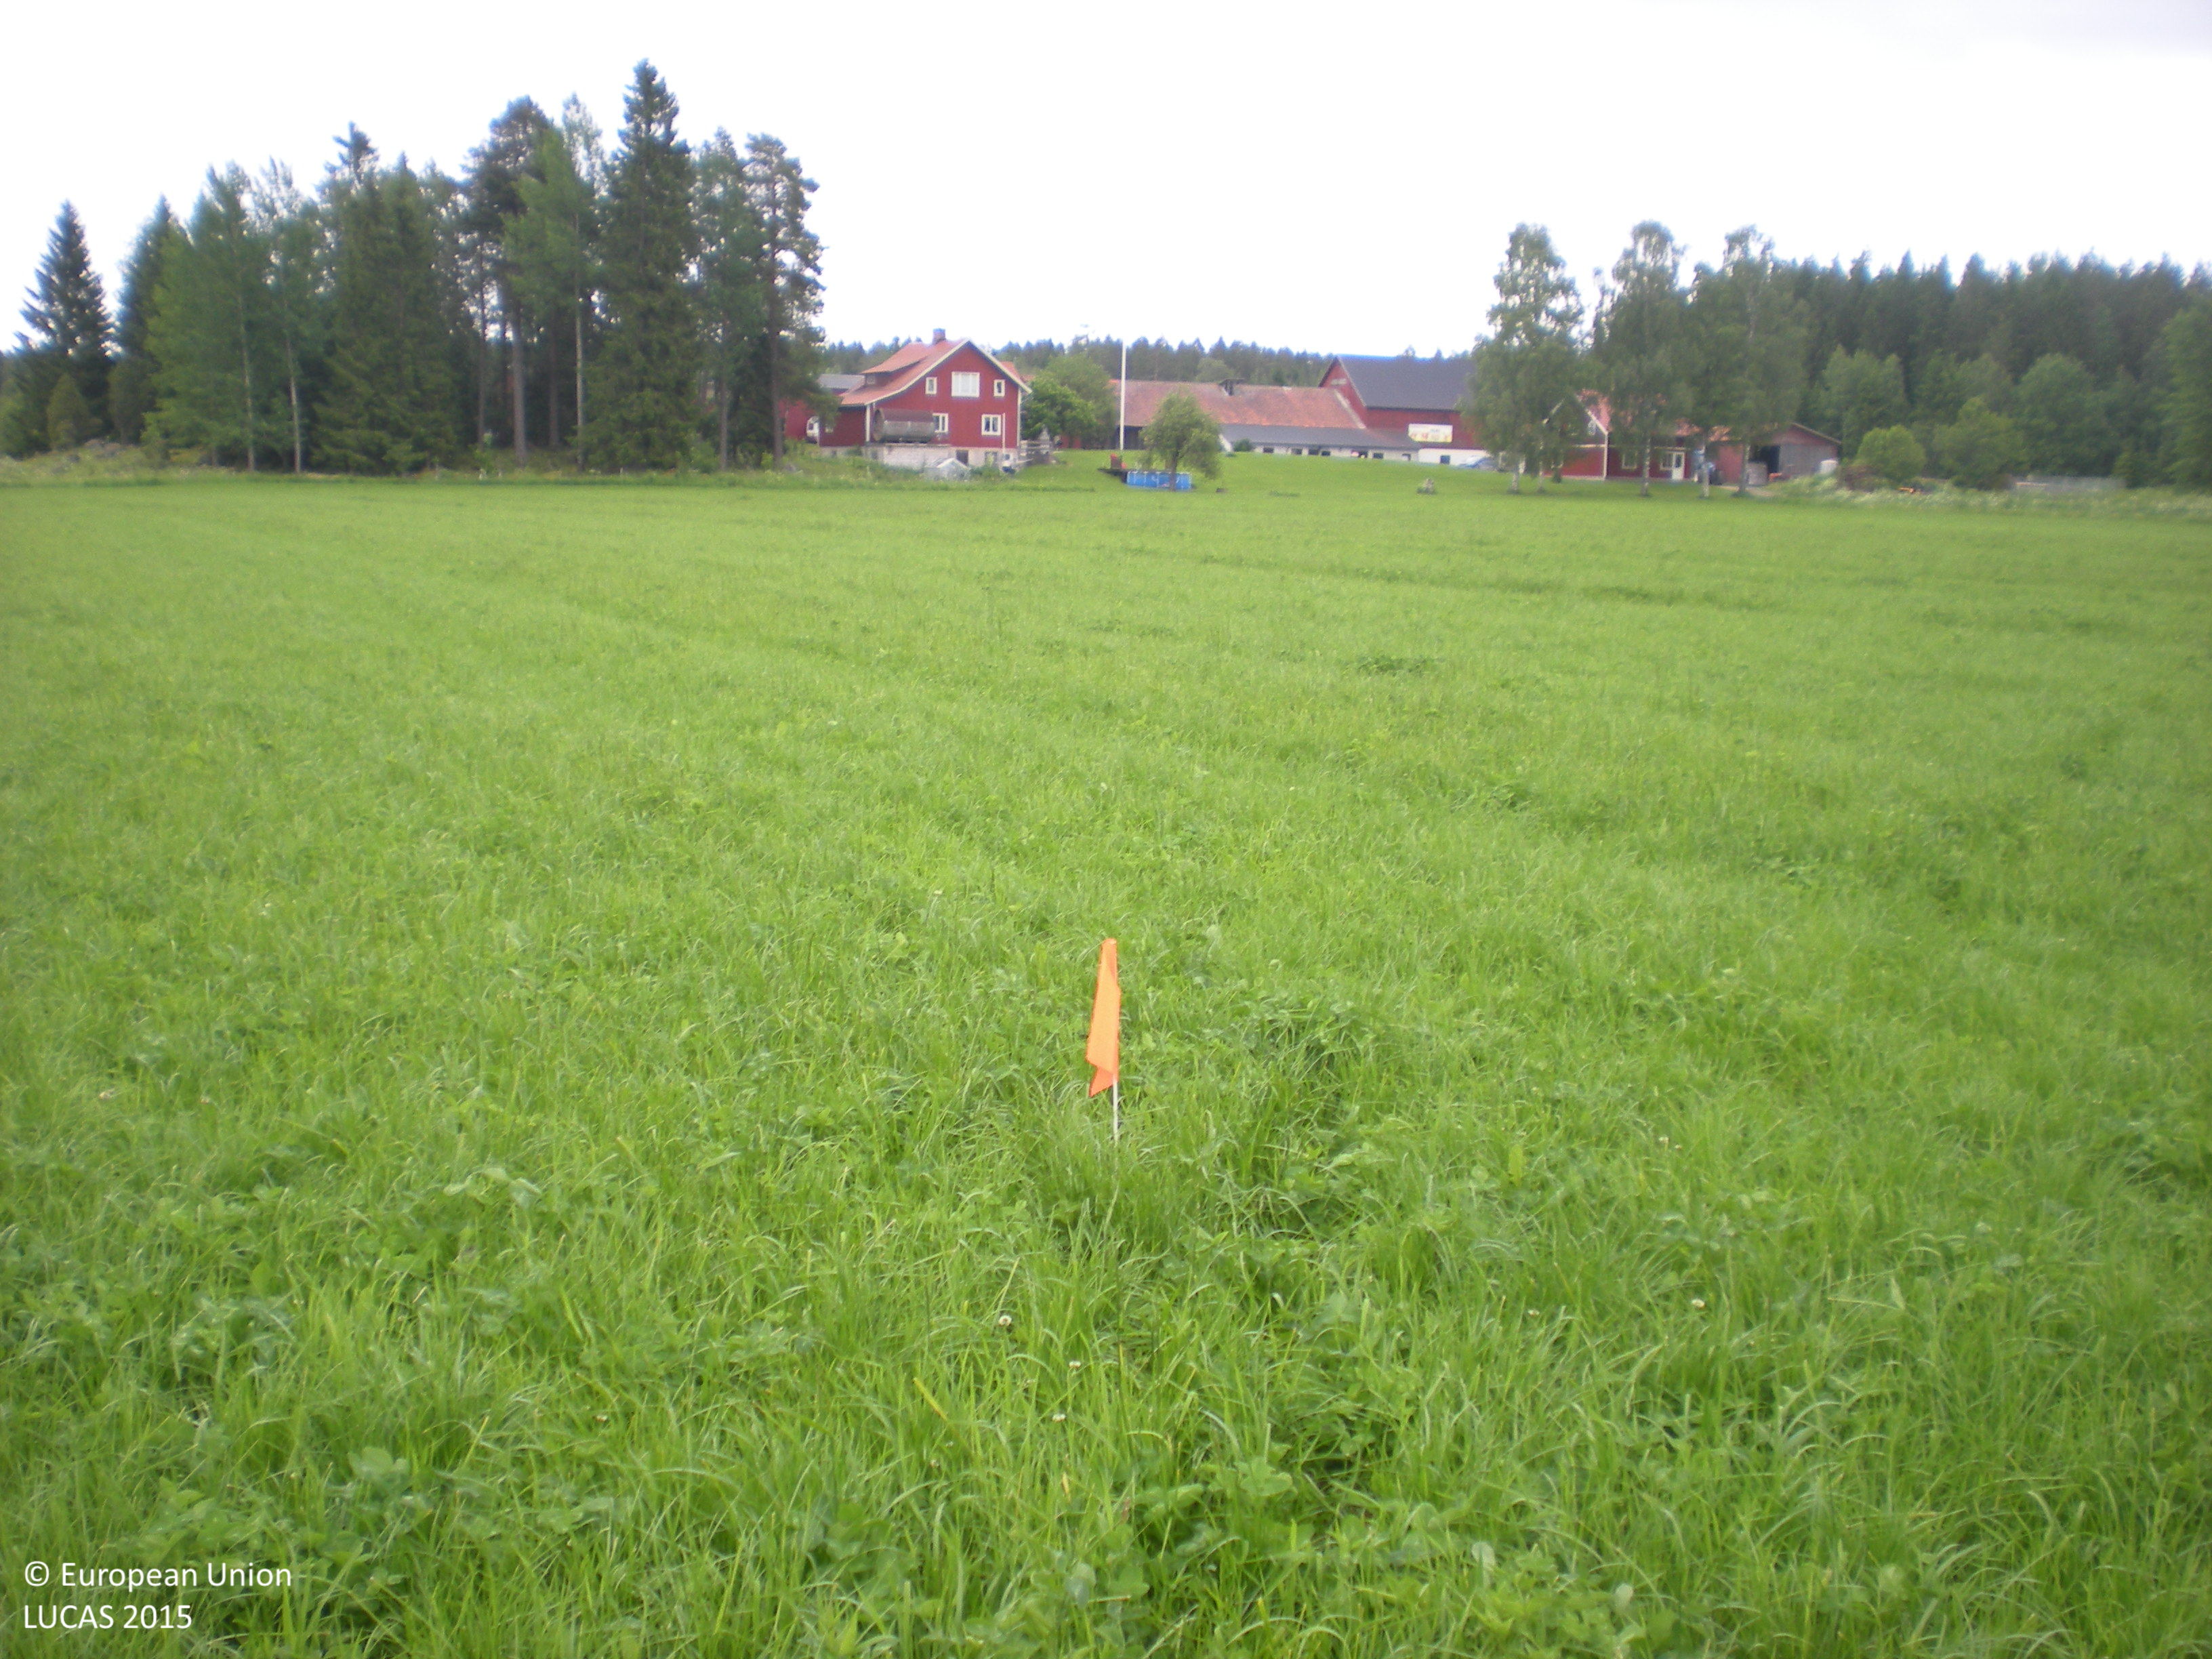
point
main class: Cropland
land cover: Other leguminous and mixtures for fodder
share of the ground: > 75 %
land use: Agriculture (excluding fallow land and kitchen gardens)
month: June
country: SE
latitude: 60.3665
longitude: 17.7343
